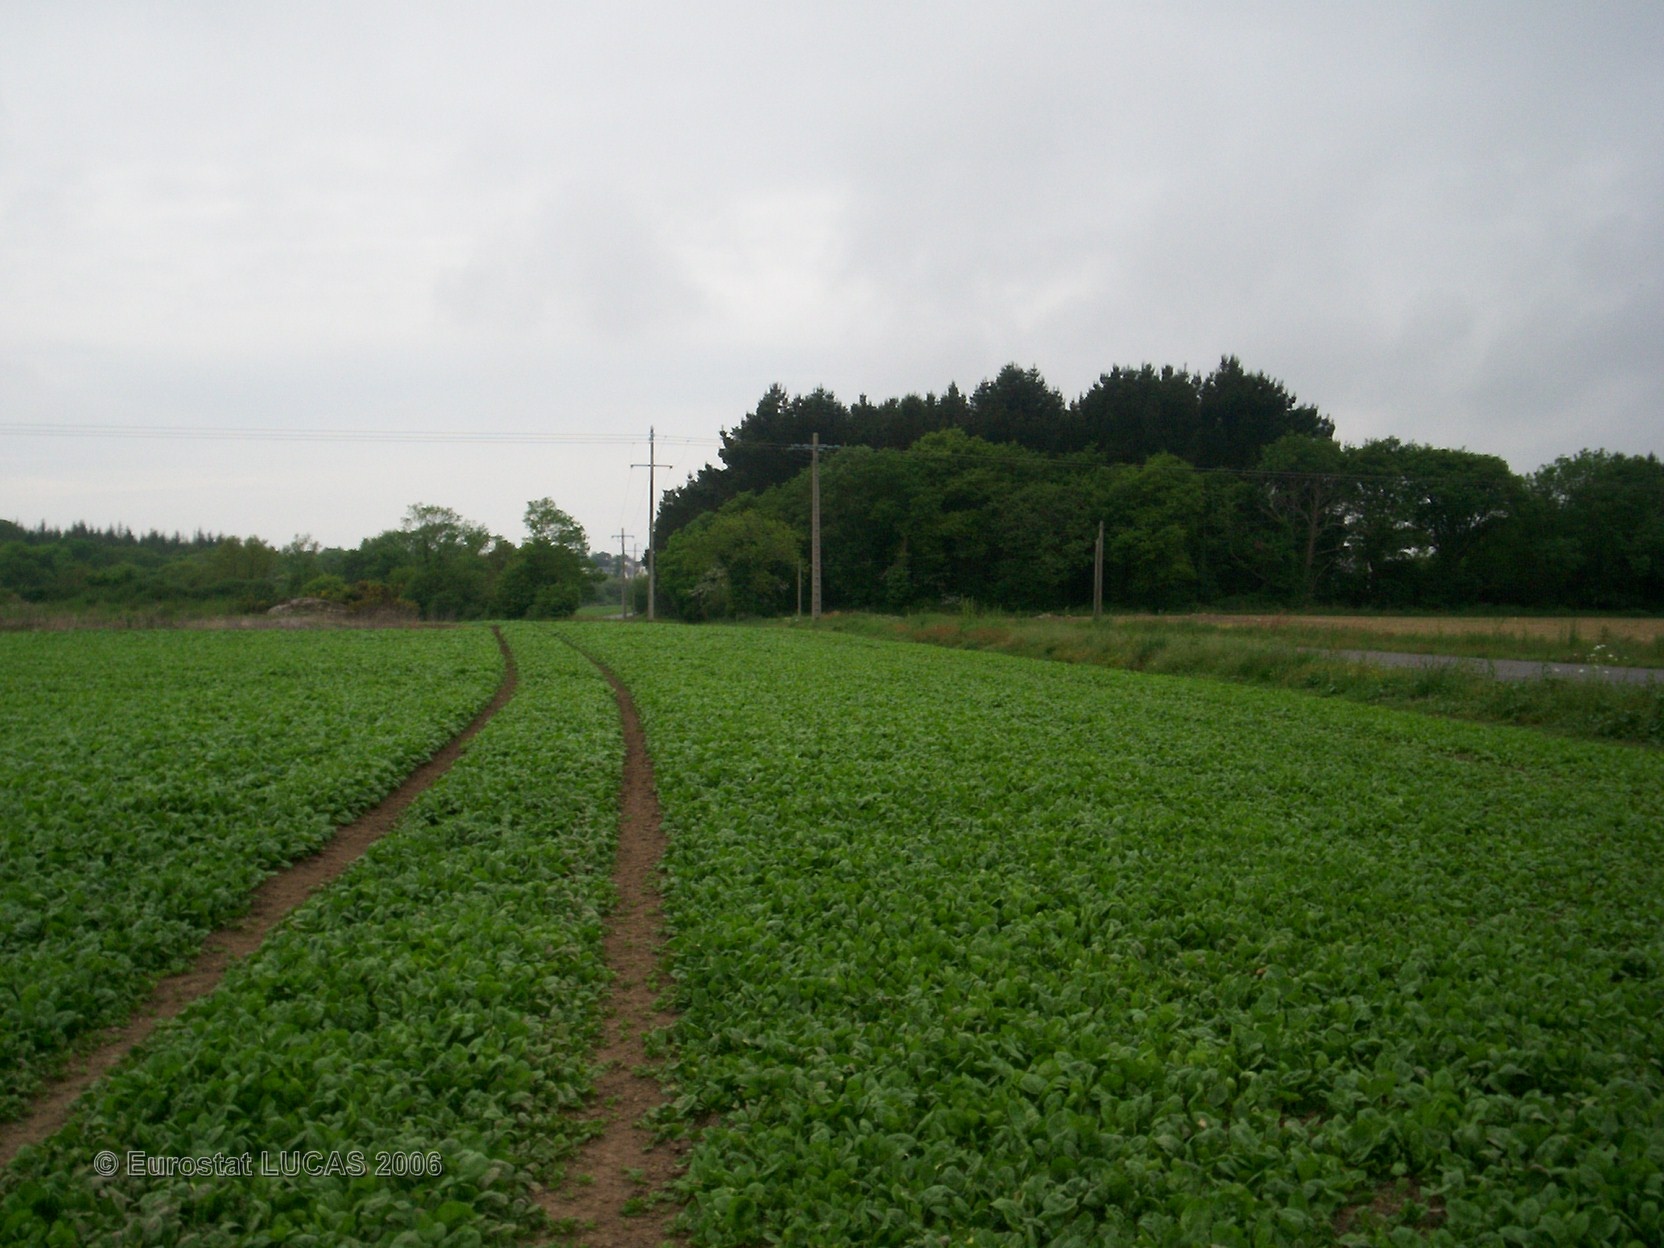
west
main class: Cropland
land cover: Other fresh vegetables
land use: Agriculture (excluding fallow land and kitchen gardens)
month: May
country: FR
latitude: 47.8536
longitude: -3.8619
